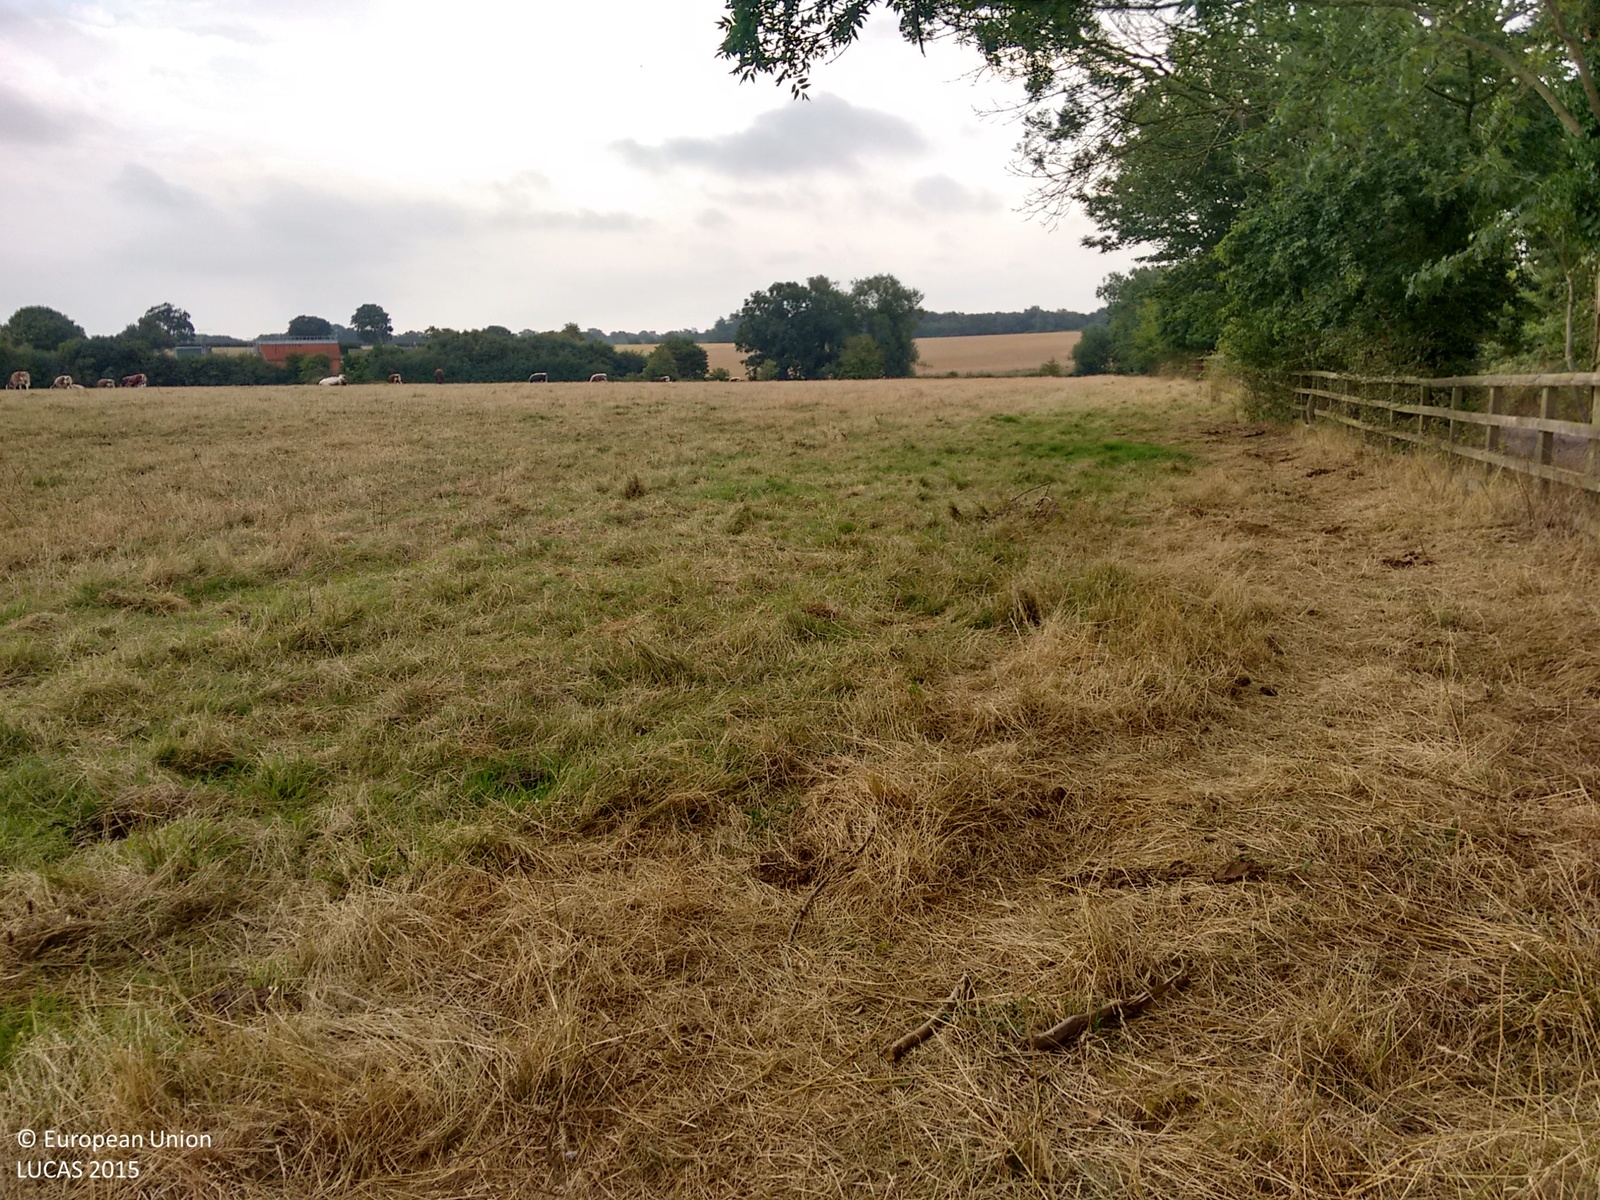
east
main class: Grassland
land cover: Grassland without tree/shrub cover
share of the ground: > 75 %
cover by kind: herbaceous plants 100 %
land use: Agriculture (excluding fallow land and kitchen gardens)
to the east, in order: Grassland without tree/shrub cover; Fences; Grass margins; Paved roads, cycling and walking lanes; Shruby margins; Rivers and streams; Shruby margins; Spontaneously vegetated surfaces; Common wheat
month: August
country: GB
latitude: 52.0003
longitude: 1.0188
